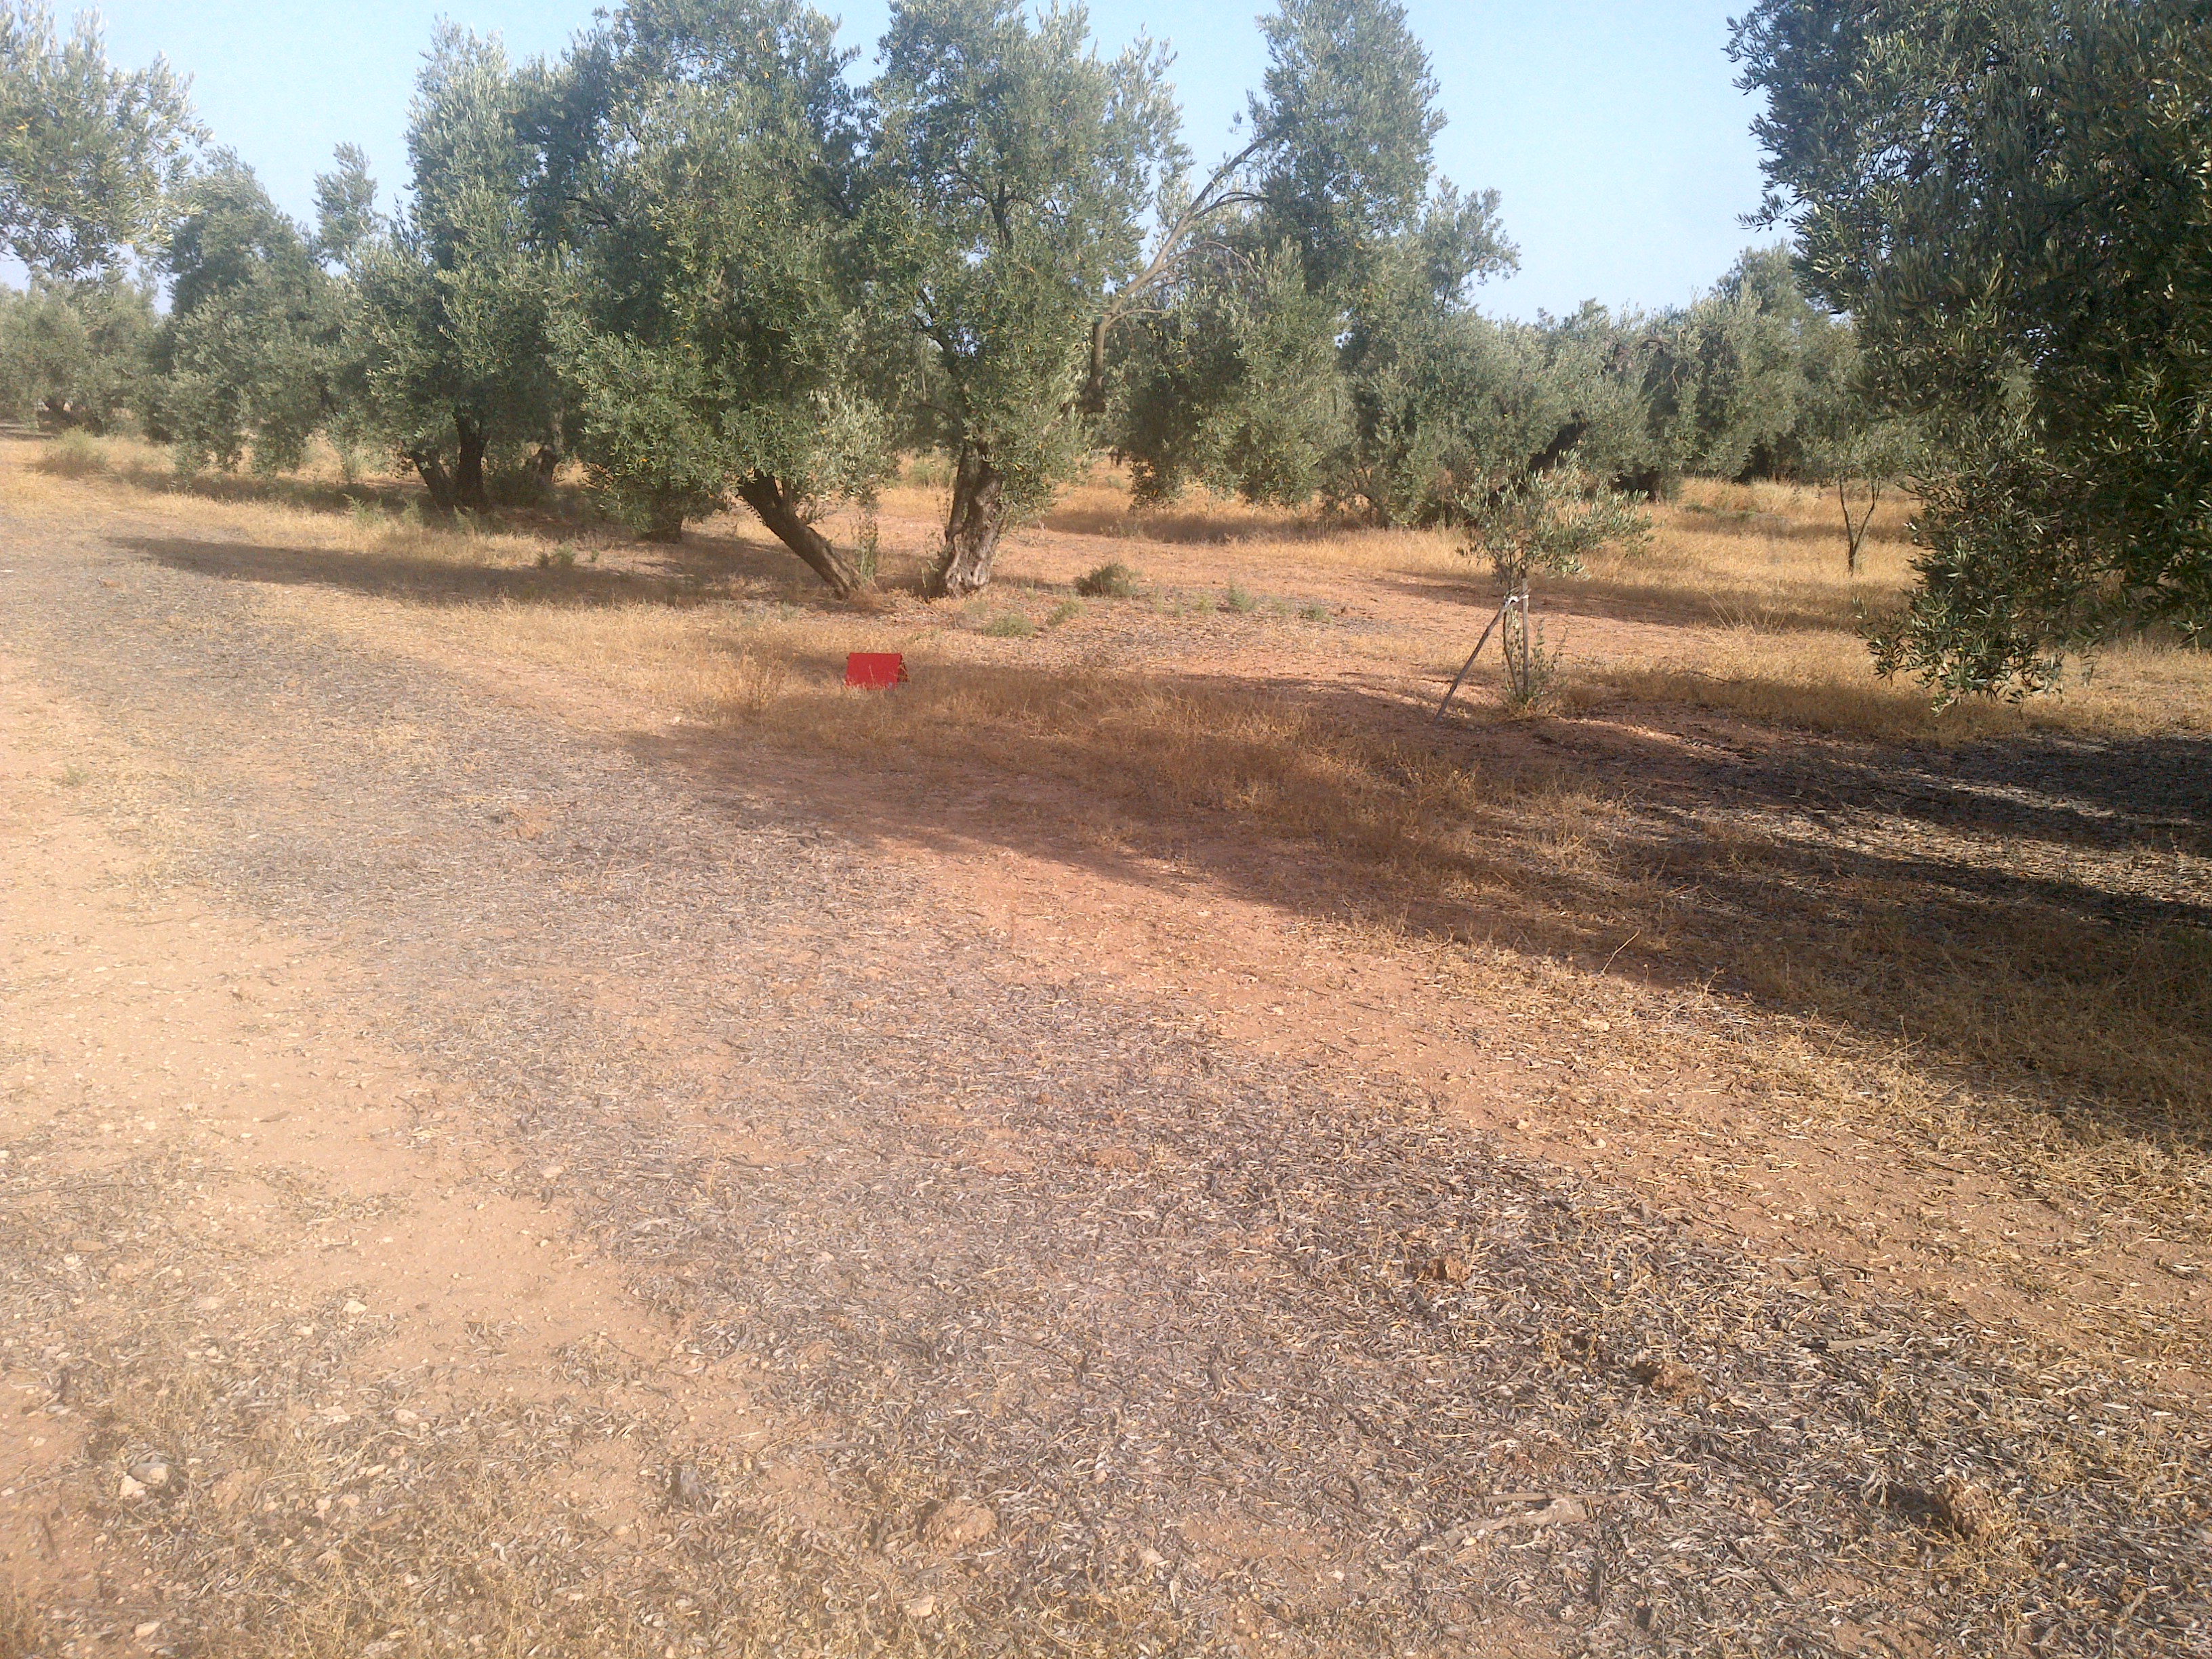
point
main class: Cropland
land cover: Olive groves
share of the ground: 50 - 75 %
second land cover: Spontaneously vegetated surfaces
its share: 10 - 25 %
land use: Agriculture (excluding fallow land and kitchen gardens)
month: July
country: ES
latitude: 37.4717
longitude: -4.8777
